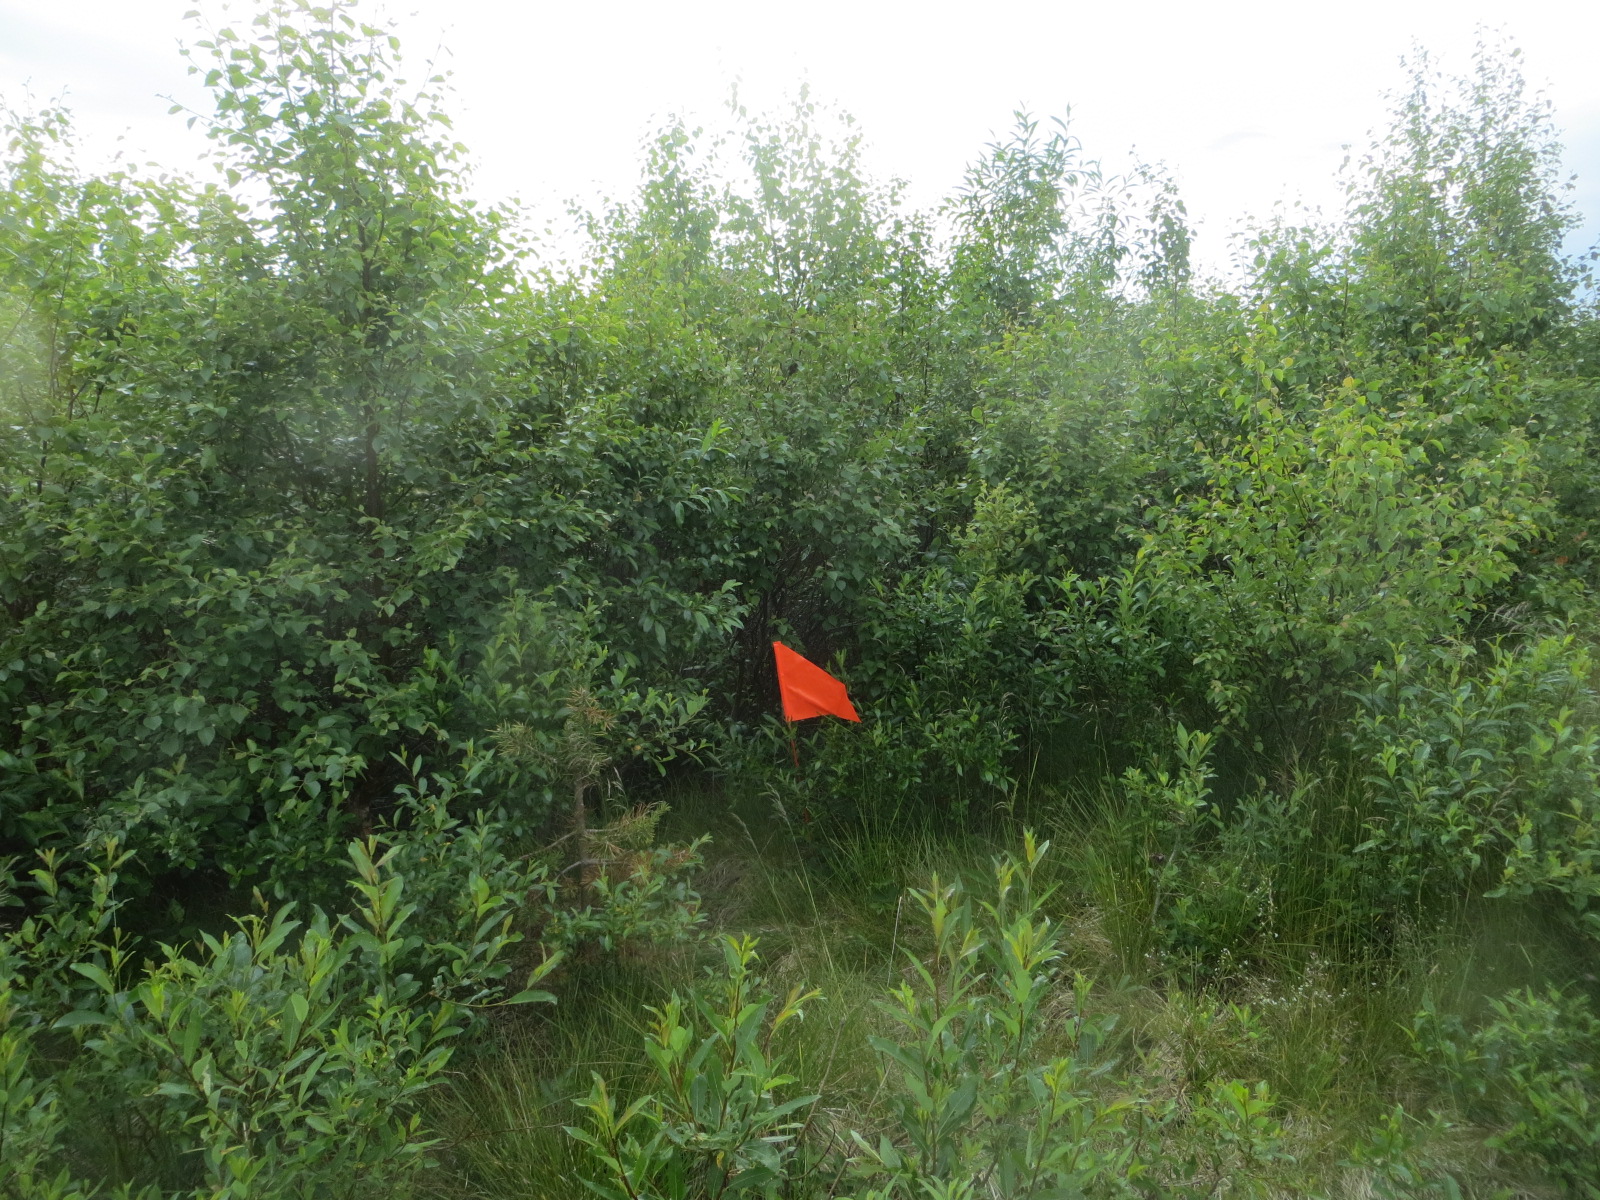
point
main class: Woodland
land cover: Broadleaved woodland
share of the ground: > 75 %
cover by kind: broadleaved forest trees 95 %, herbaceous plants 5 %
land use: Abandoned areas
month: July
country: FI
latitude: 65.9792
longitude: 26.0897
